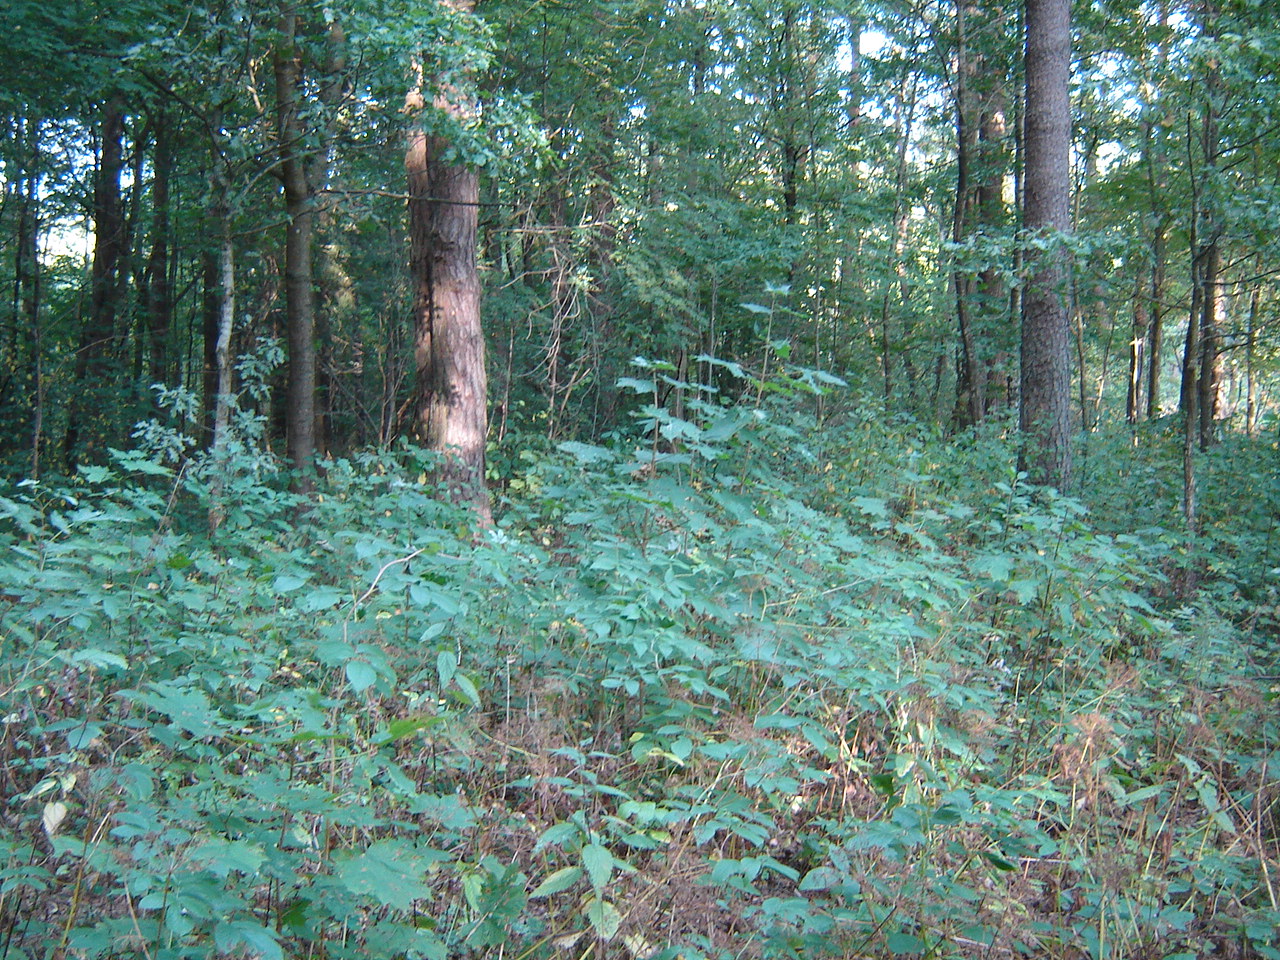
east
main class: Woodland
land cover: Pine dominated mixed woodland
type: hemiboreal forest and nemoral coniferous forest and mixed broadleaved-coniferous forest
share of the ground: > 75 %
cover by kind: coniferous forest trees 55 %, broadleaved forest trees 30 %, herbaceous plants 15 %
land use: Forestry
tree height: > 5 m
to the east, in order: Pine dominated mixed woodland; Electric lines; Pine dominated mixed woodland; Pine dominated coniferous woodland; Pine dominated mixed woodland; Paved roads, cycling and walking lanes; Grass margins; Pine dominated mixed woodland
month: August
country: LT
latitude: 54.6125
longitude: 25.2167
